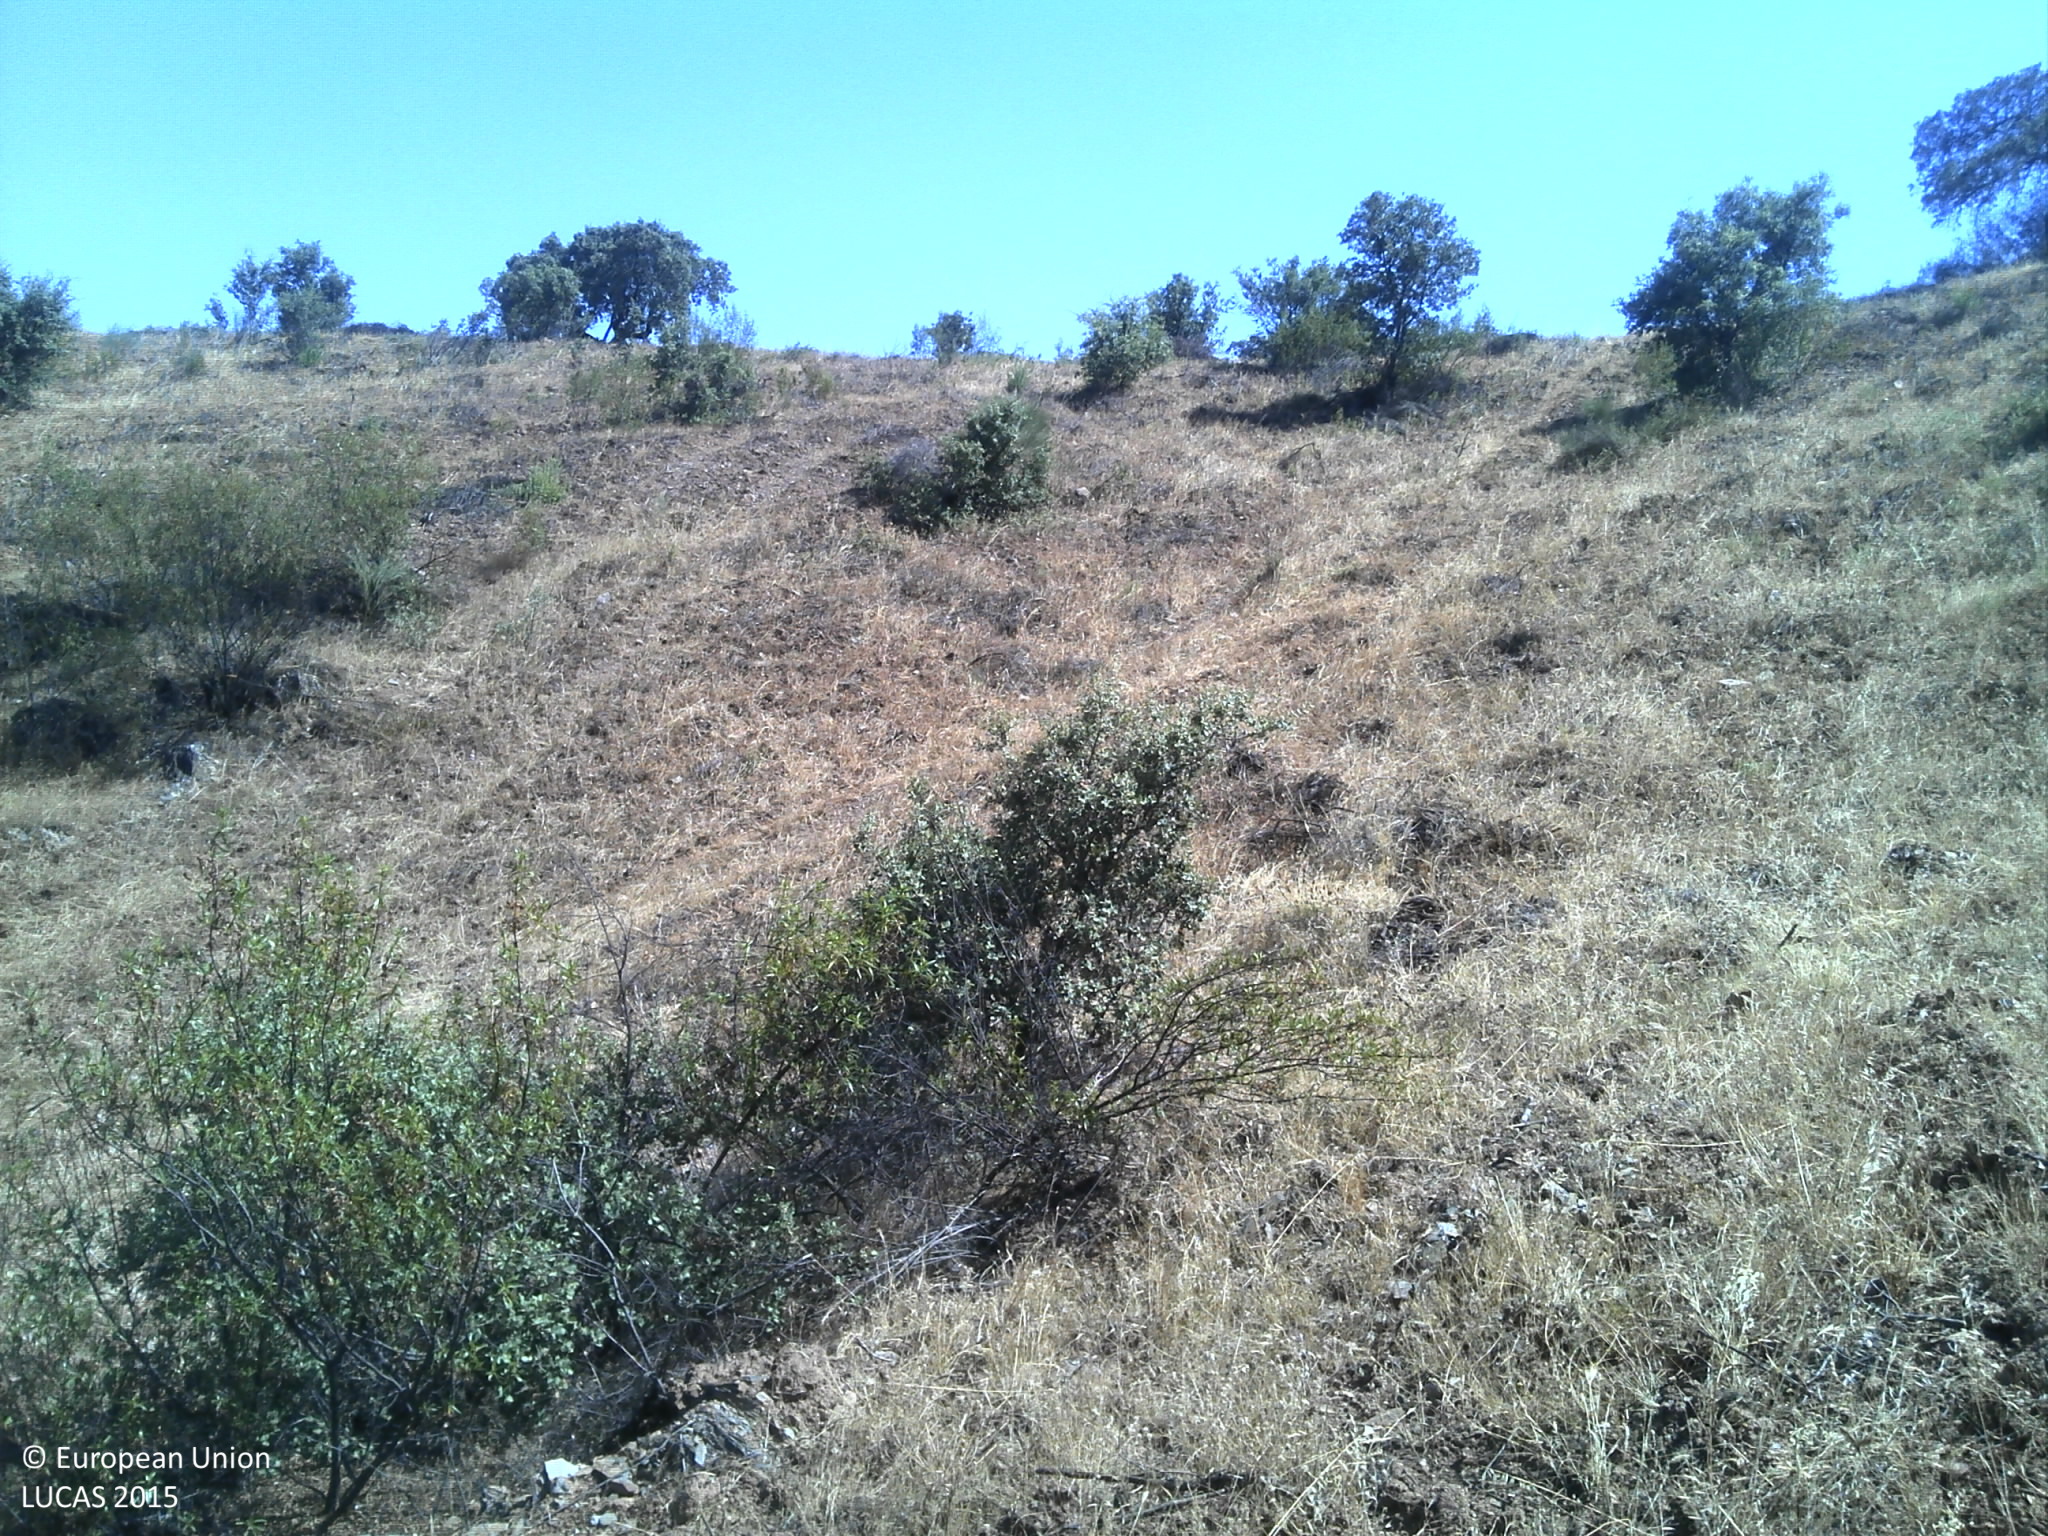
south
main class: Grassland
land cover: Grassland with sparse tree/shrub cover
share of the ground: 25 - 50 %
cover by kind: herbaceous plants 40 %, unconsolidated bare surface 40 %, broadleaved forest trees 5 %, shrubs 5 %
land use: Agriculture (excluding fallow land and kitchen gardens)
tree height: < 5 m
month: June
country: PT
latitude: 39.9889
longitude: -7.2054
